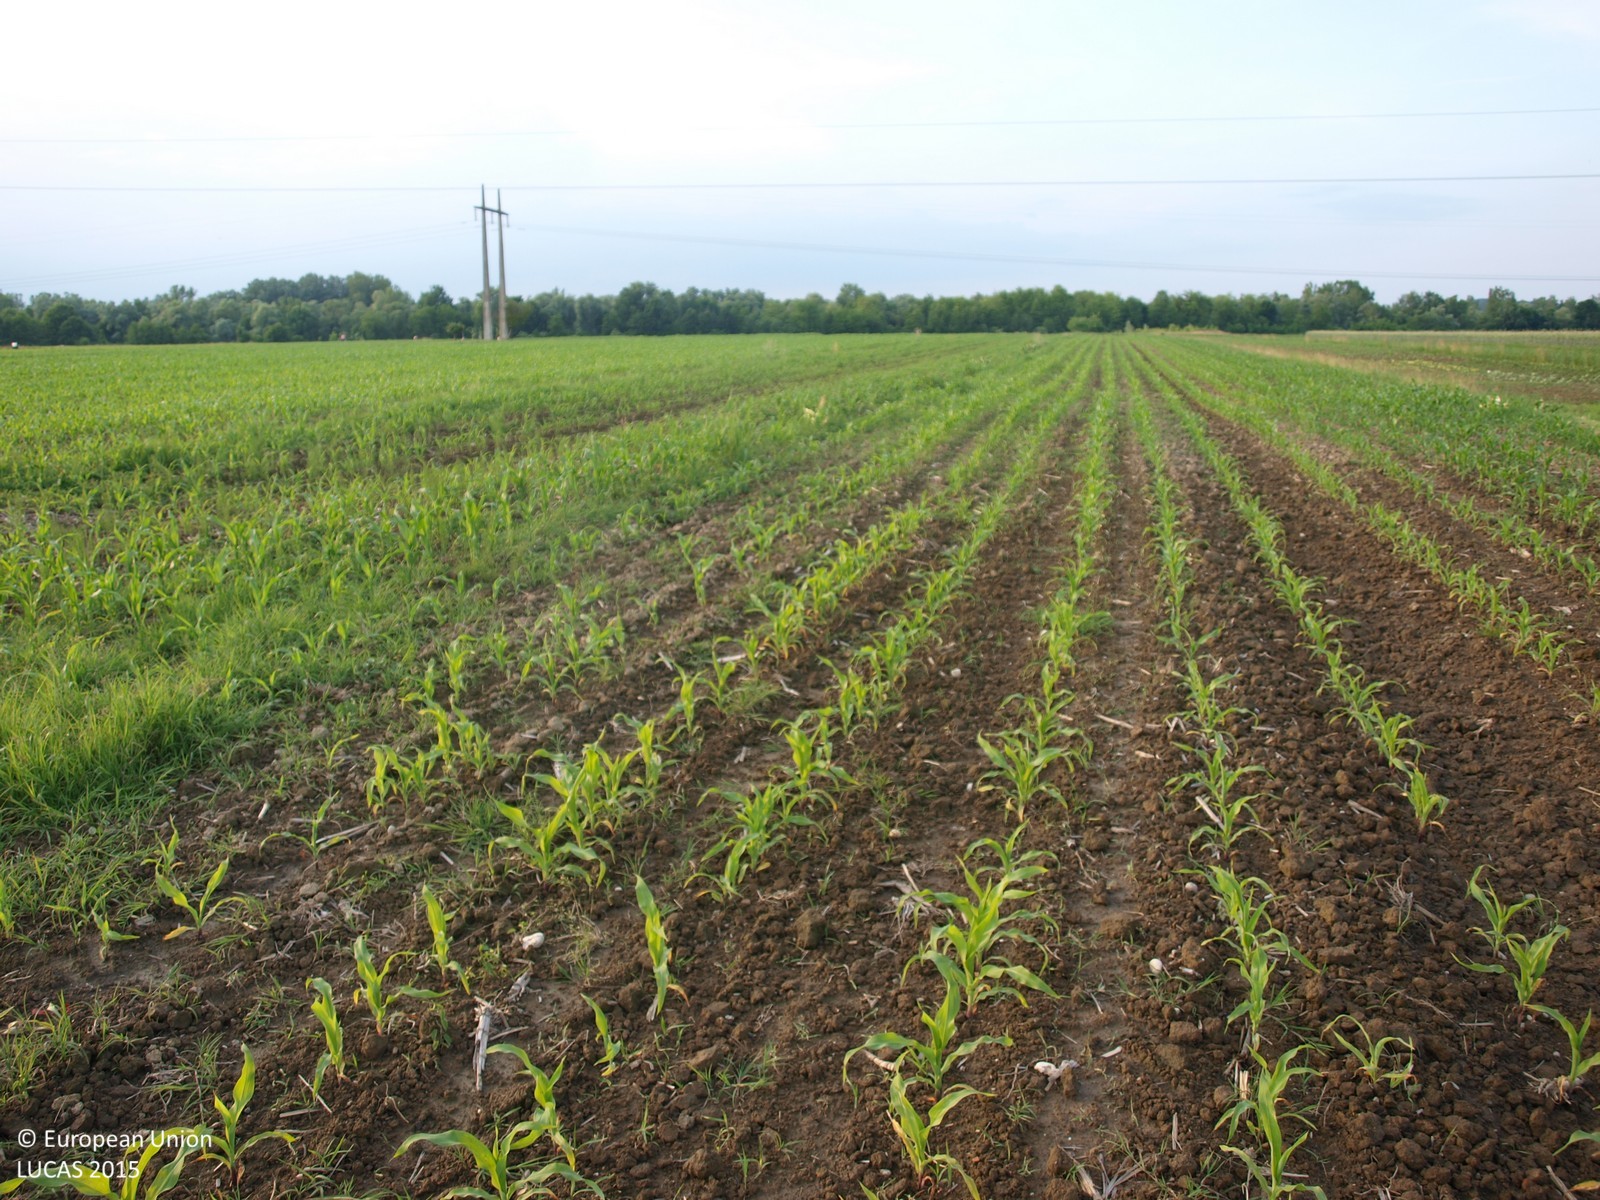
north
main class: Cropland
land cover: Maize
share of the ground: 10 - 25 %
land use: Agriculture (excluding fallow land and kitchen gardens)
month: June
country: HR
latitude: 46.3759
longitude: 16.0970
